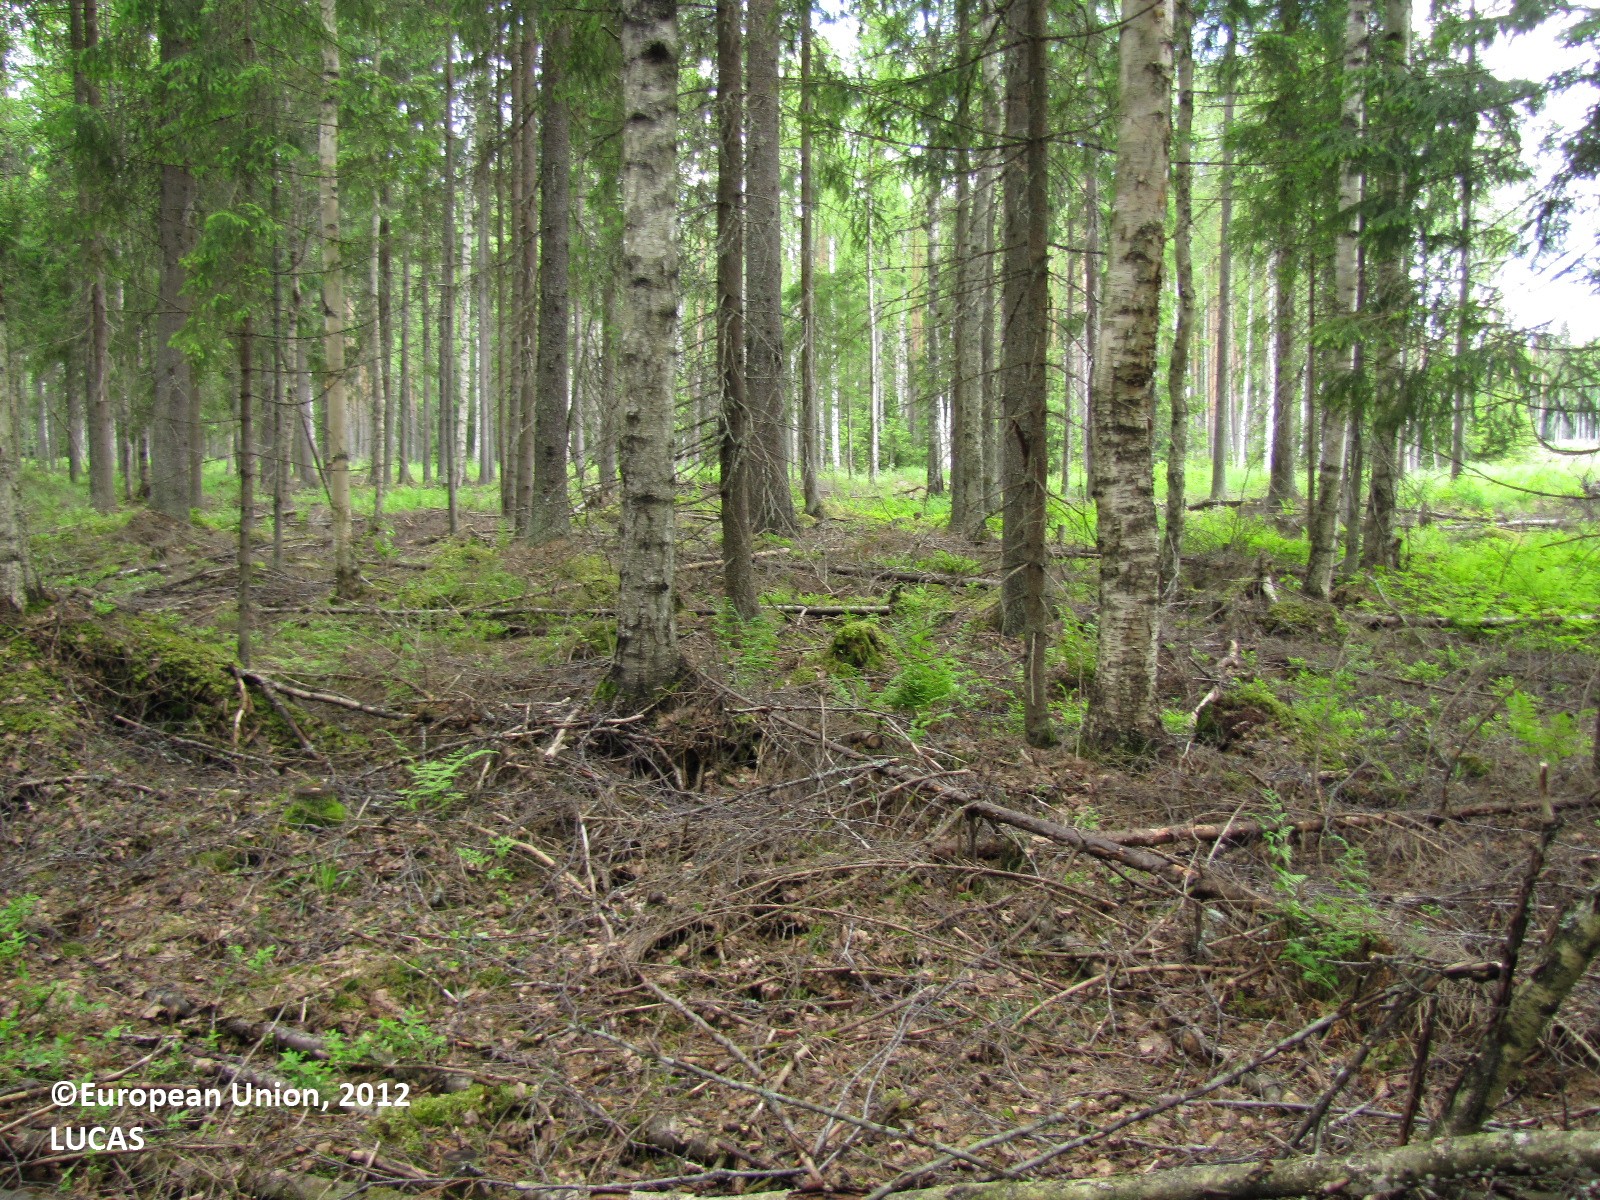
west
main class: Woodland
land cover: Spruce dominated mixed woodland
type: hemiboreal forest and nemoral coniferous forest and mixed broadleaved-coniferous forest
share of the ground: 50 - 75 %
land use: Forestry
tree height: > 5 m
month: June
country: FI
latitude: 61.2366
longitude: 23.4377
